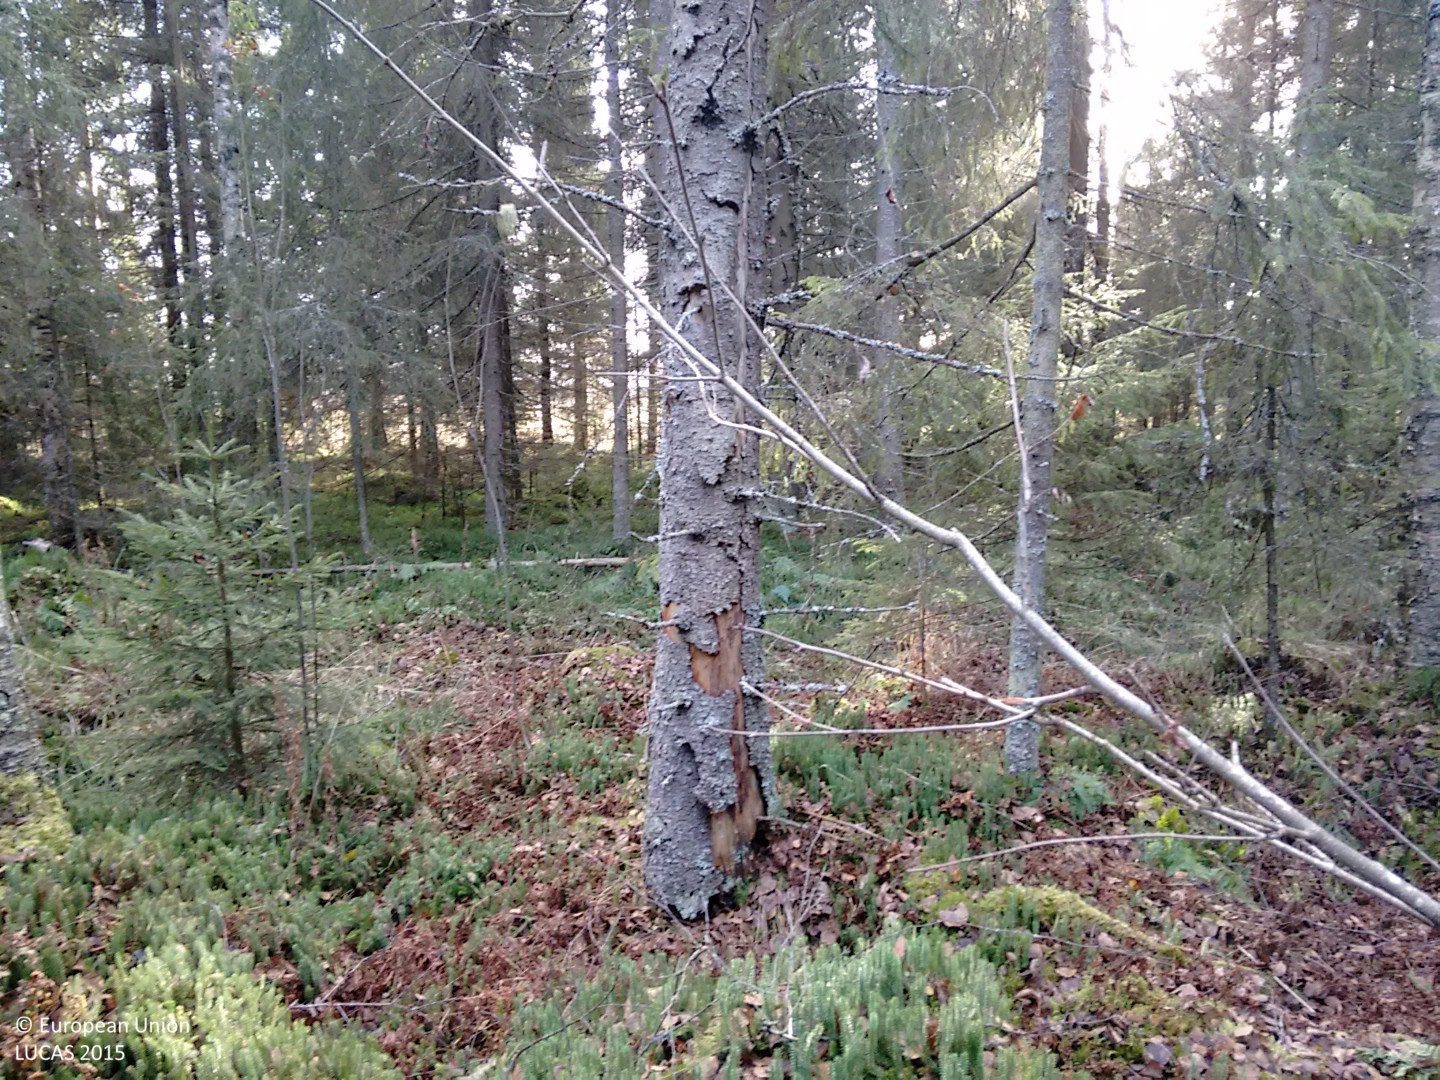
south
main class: Woodland
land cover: Spruce dominated mixed woodland
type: boreal forest
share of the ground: > 75 %
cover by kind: coniferous forest trees 60 %, broadleaved forest trees 25 %, herbaceous plants 10 %, shrubs 5 %
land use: Forestry
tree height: > 5 m
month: October
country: FI
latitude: 63.9186
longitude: 25.1964
